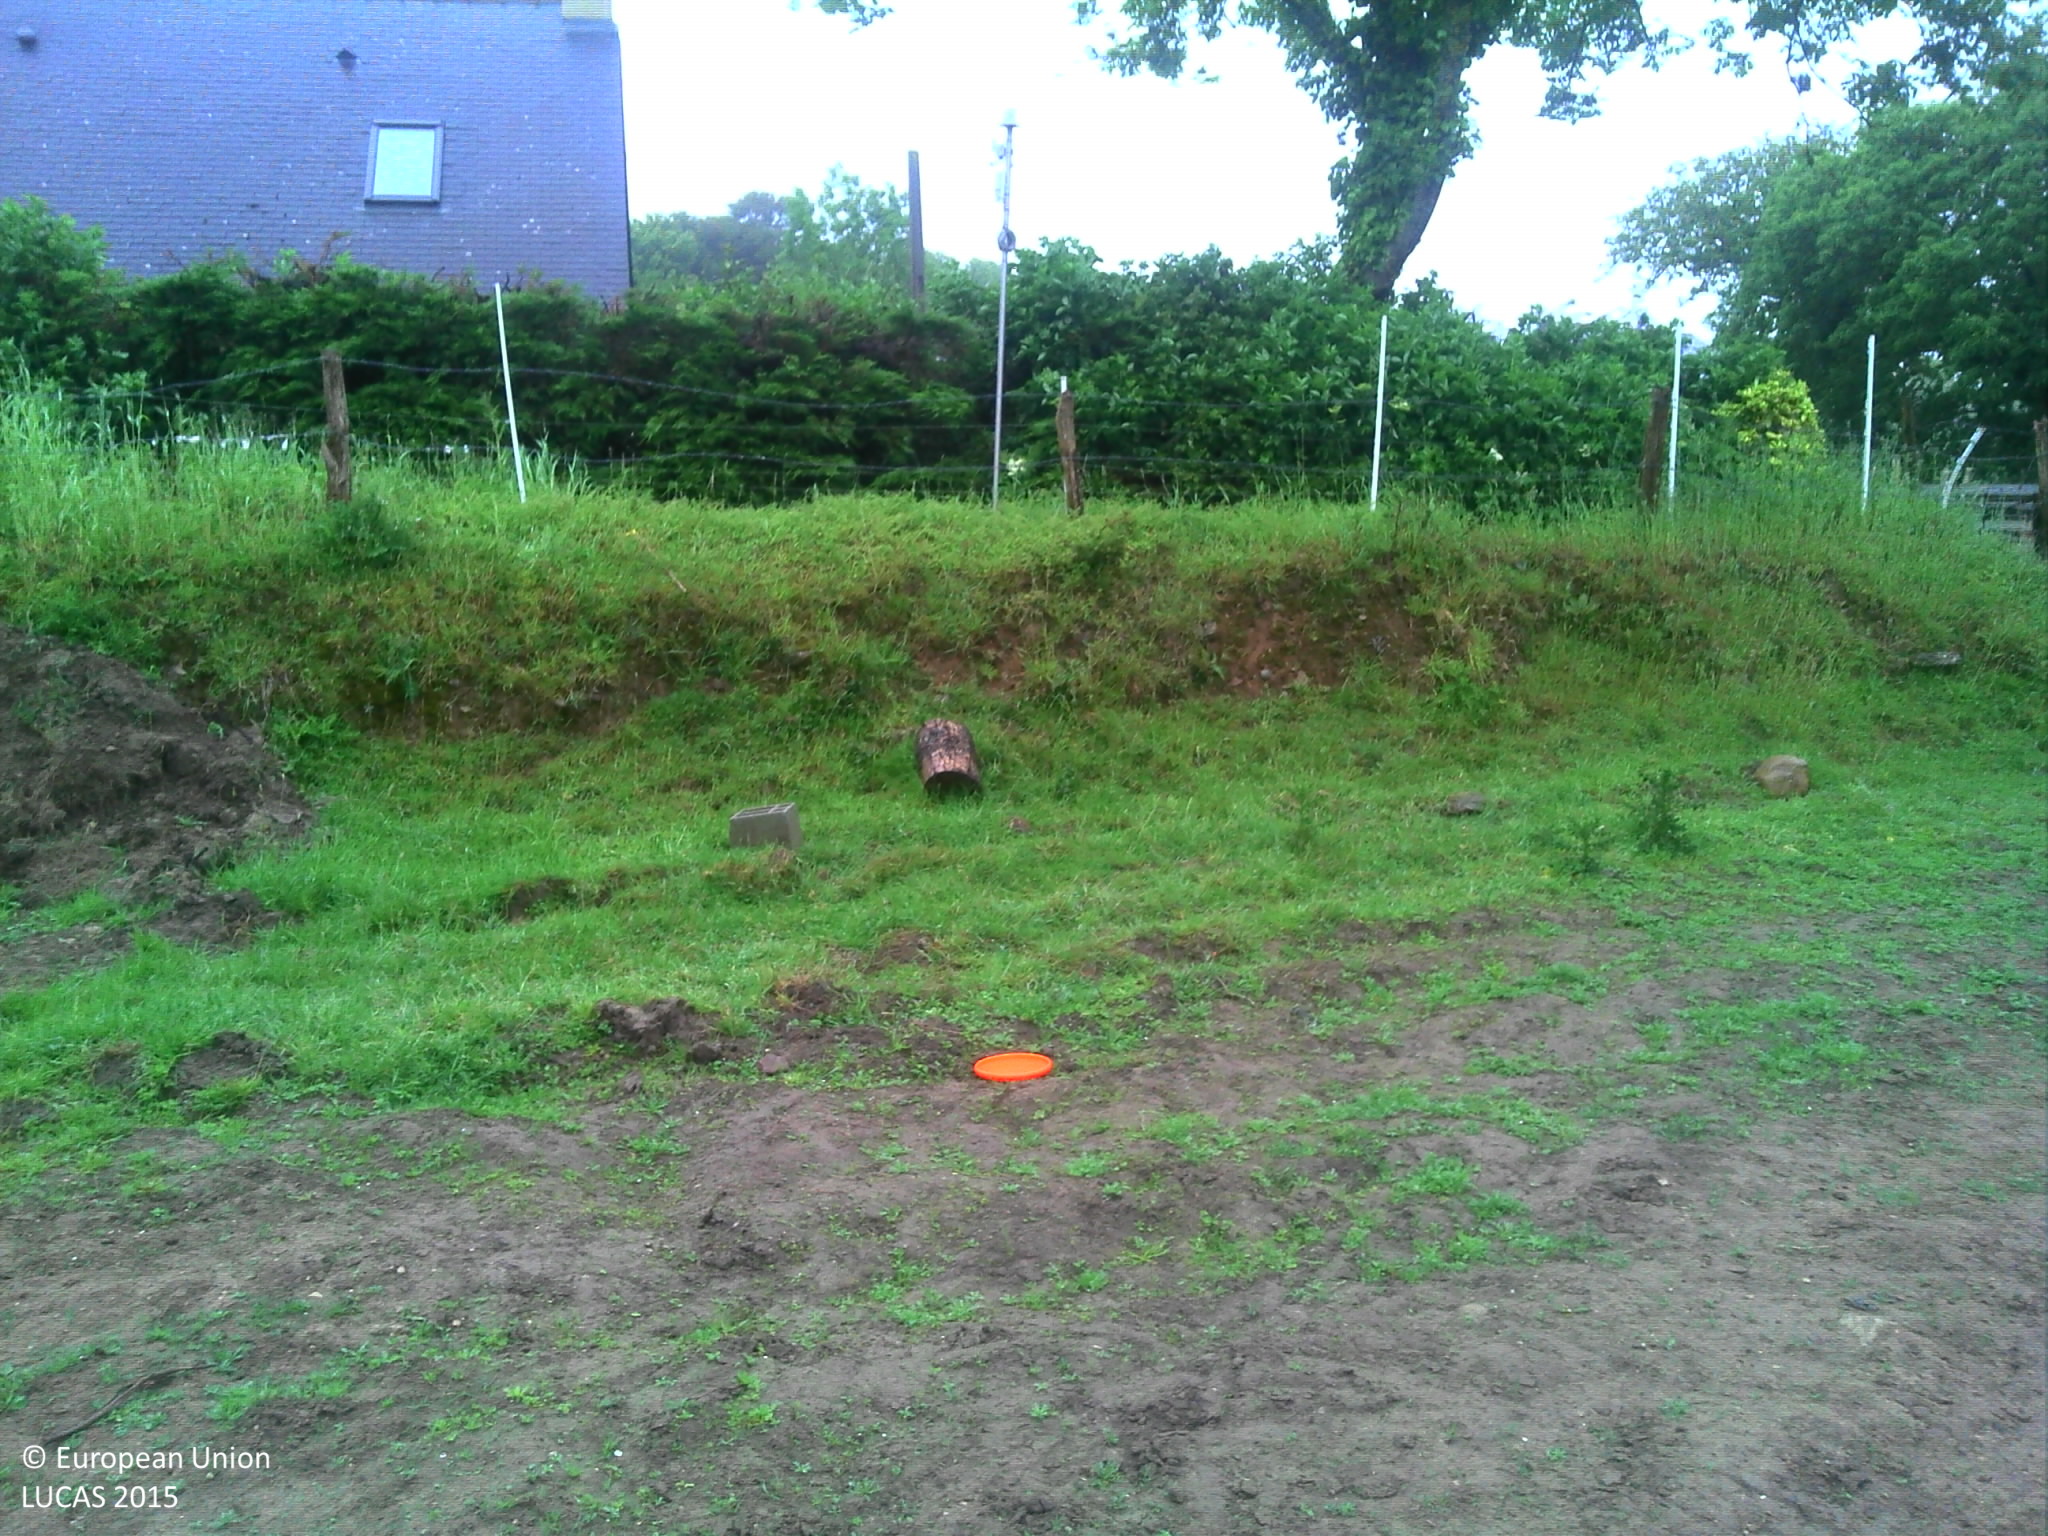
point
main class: Grassland
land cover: Grassland without tree/shrub cover
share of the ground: > 75 %
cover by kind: herbaceous plants 95 %, shrubs 5 %
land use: Agriculture (excluding fallow land and kitchen gardens)
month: June
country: FR
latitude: 49.6228
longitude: -1.8065
